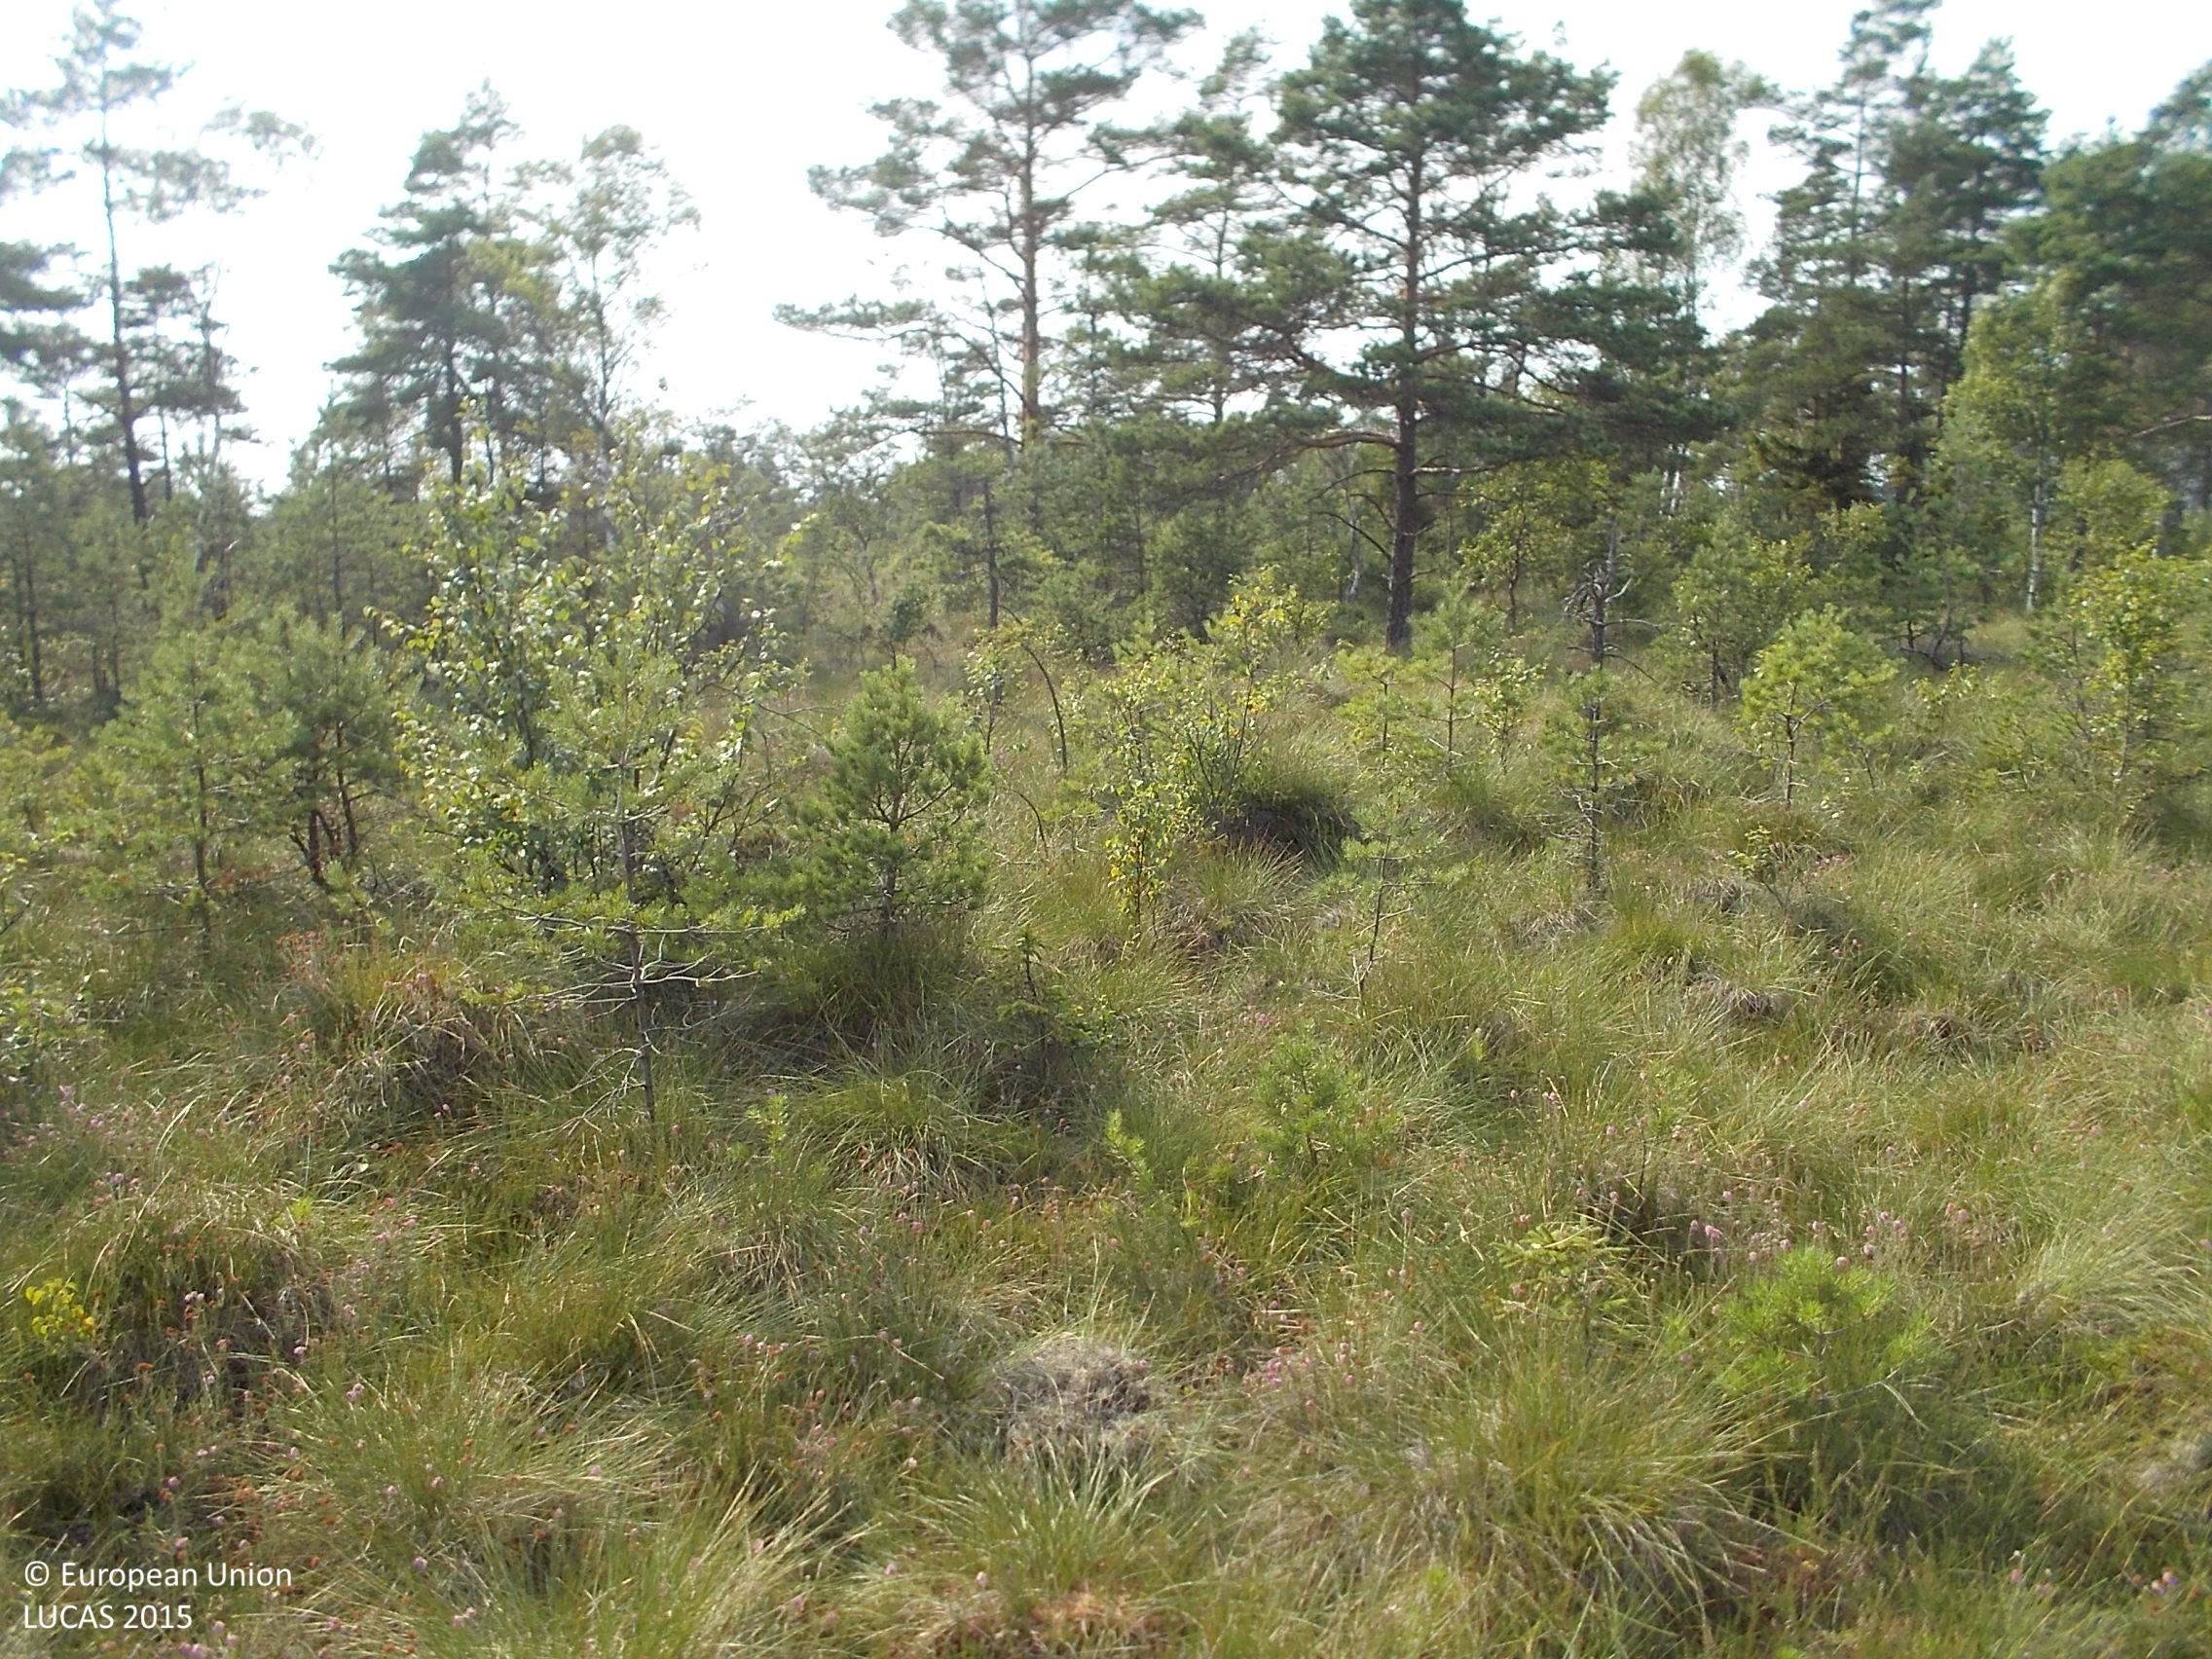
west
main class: Woodland
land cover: Pine dominated coniferous woodland
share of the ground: 25 - 50 %
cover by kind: coniferous forest trees 35 %, shrubs 30 %, herbaceous plants 30 %, broadleaved forest trees 5 %
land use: Semi-natural and natural areas not in use
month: August
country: SE
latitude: 57.5010
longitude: 13.0496
